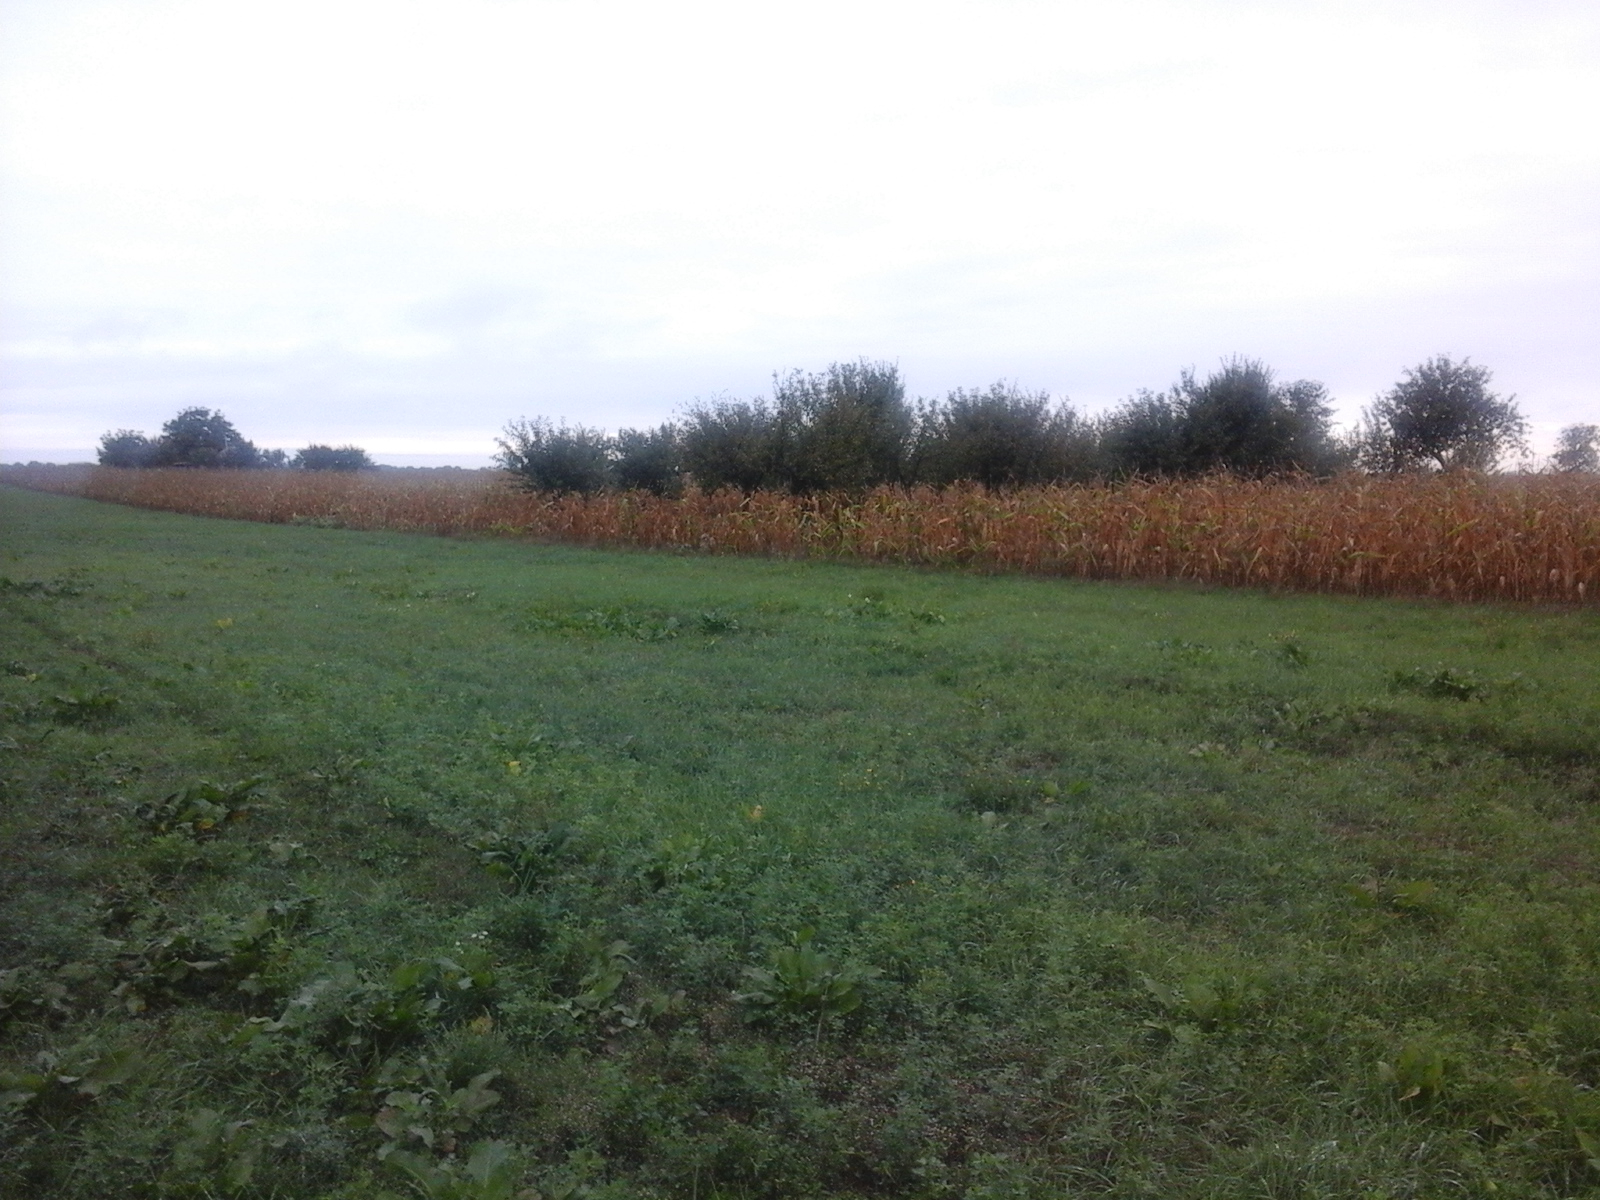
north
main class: Cropland
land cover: Lucerne
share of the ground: > 75 %
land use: Agriculture (excluding fallow land and kitchen gardens)
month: September
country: RO
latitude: 47.0299
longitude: 21.7415
